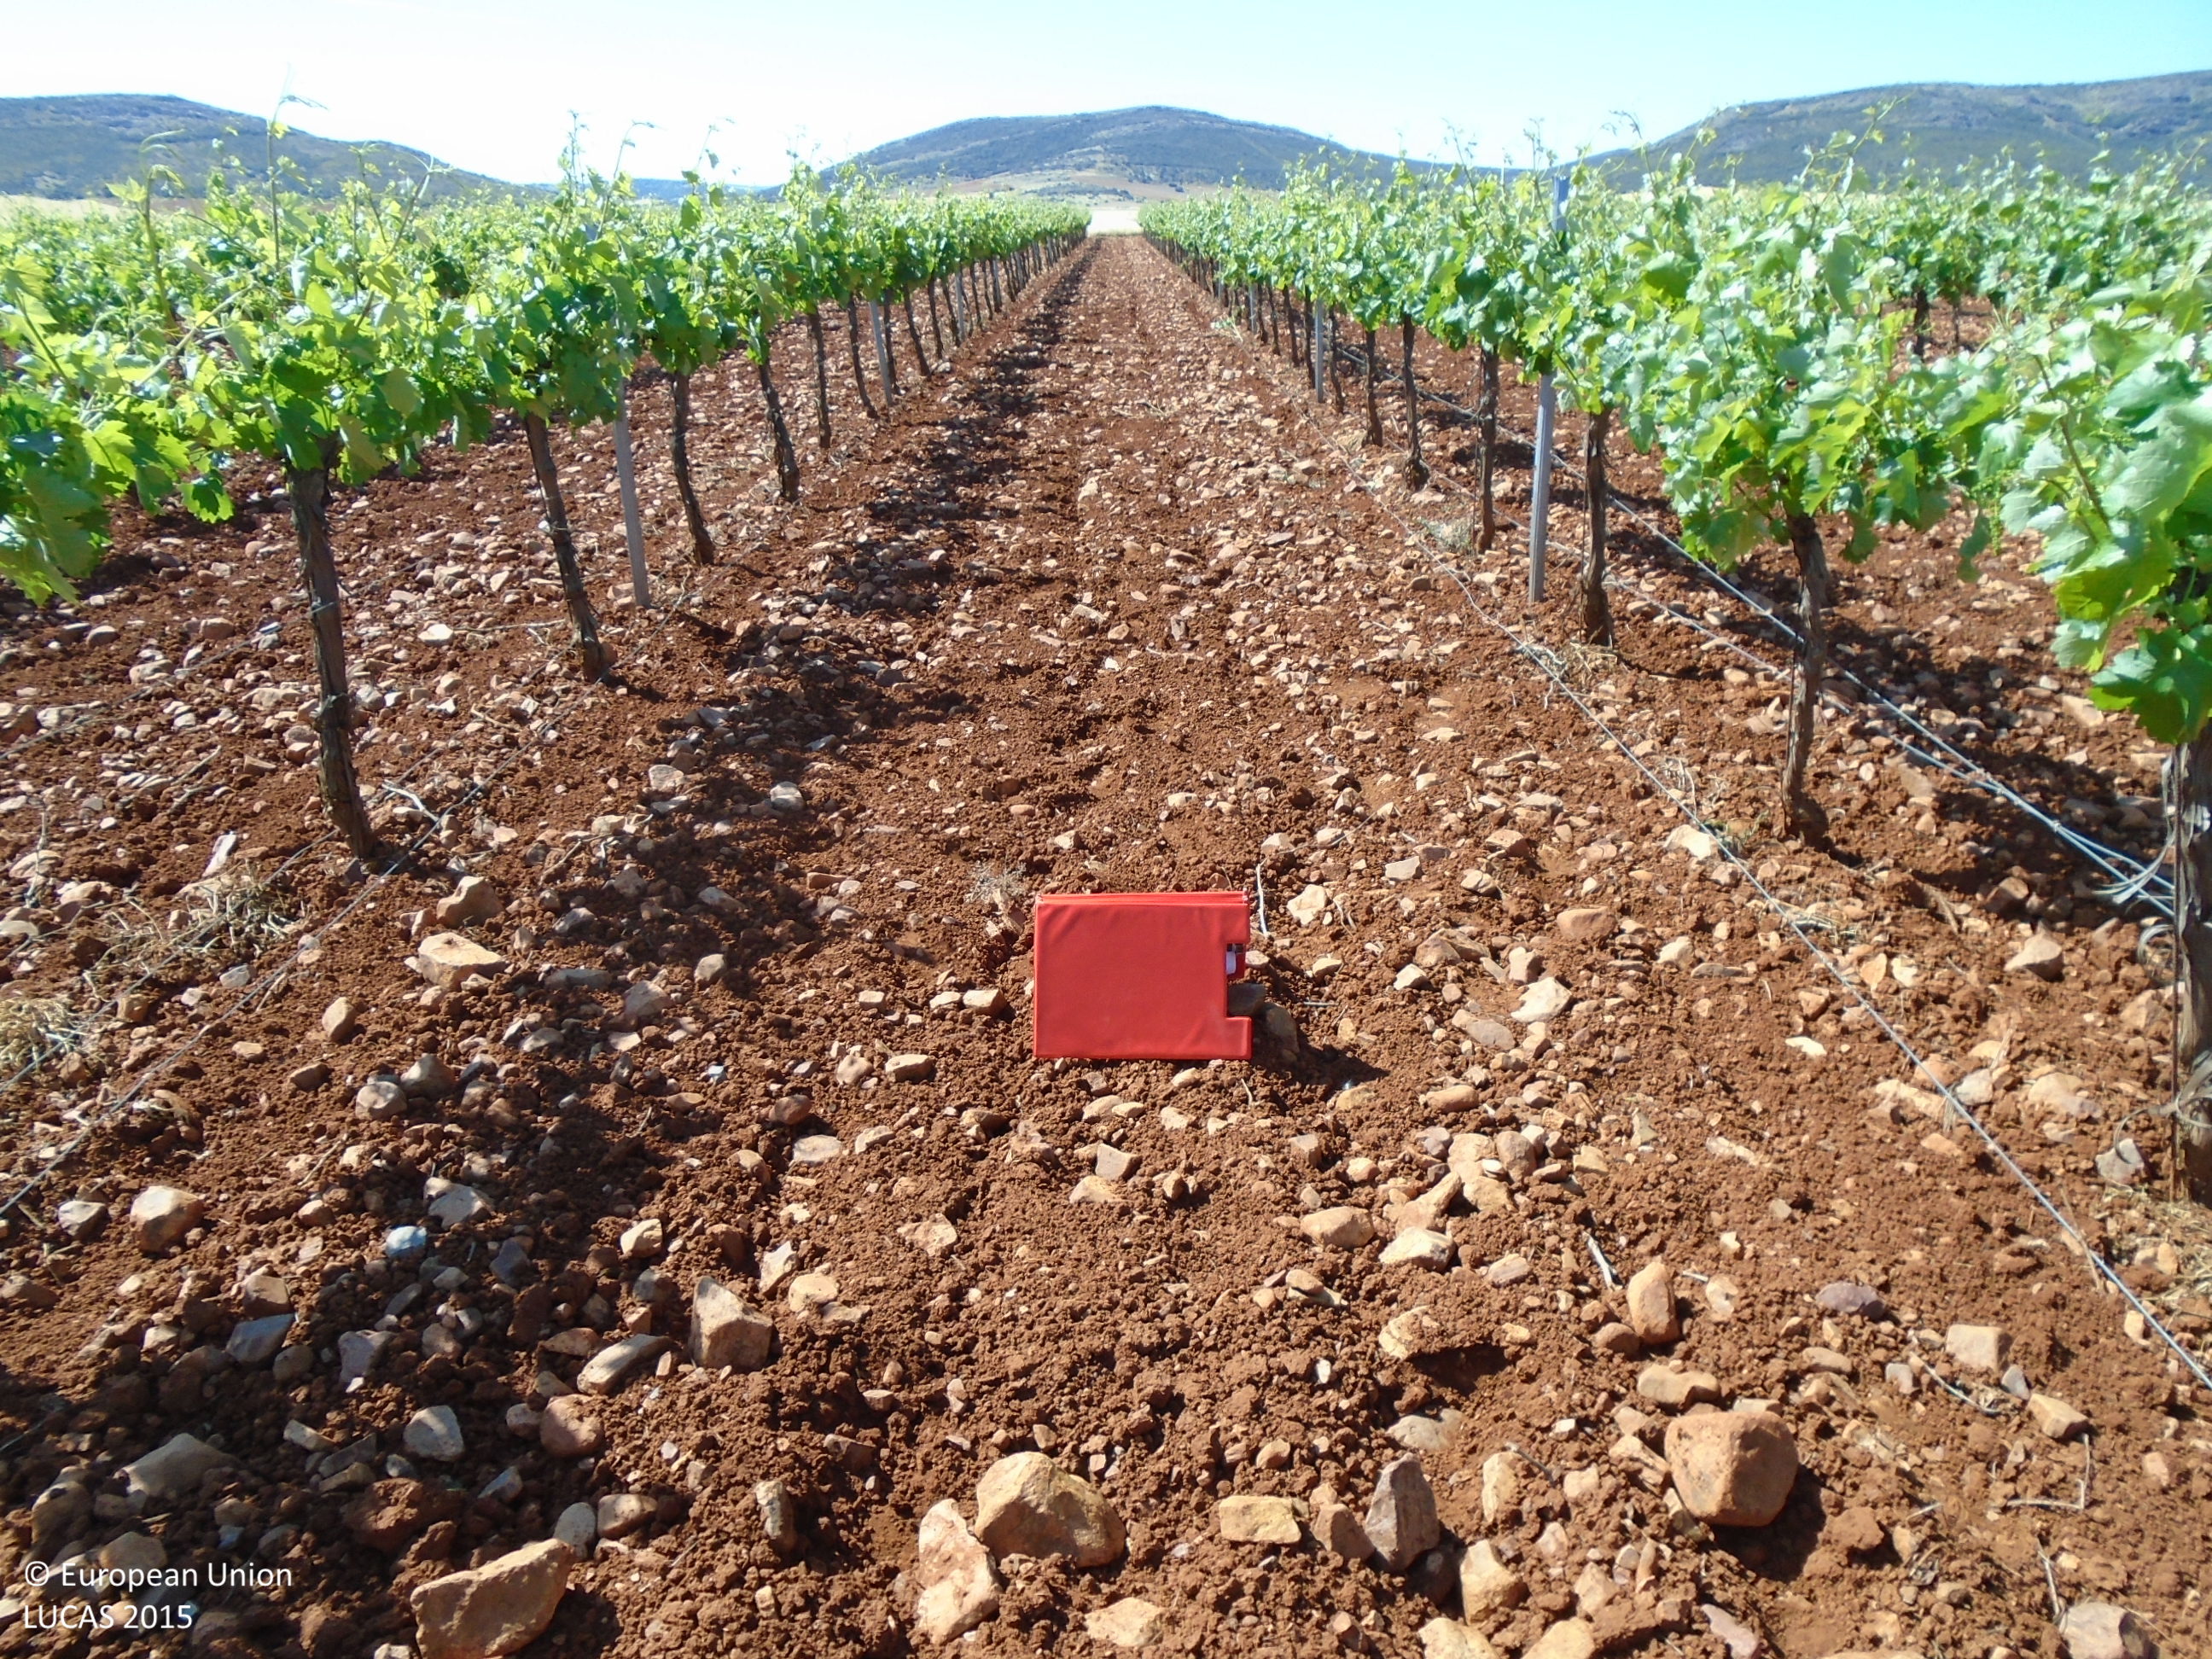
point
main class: Cropland
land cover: Vineyards
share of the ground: 25 - 50 %
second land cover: Other bare soil
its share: > 75 %
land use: Agriculture (excluding fallow land and kitchen gardens)
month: May
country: ES
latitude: 39.4832
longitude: -3.7090
